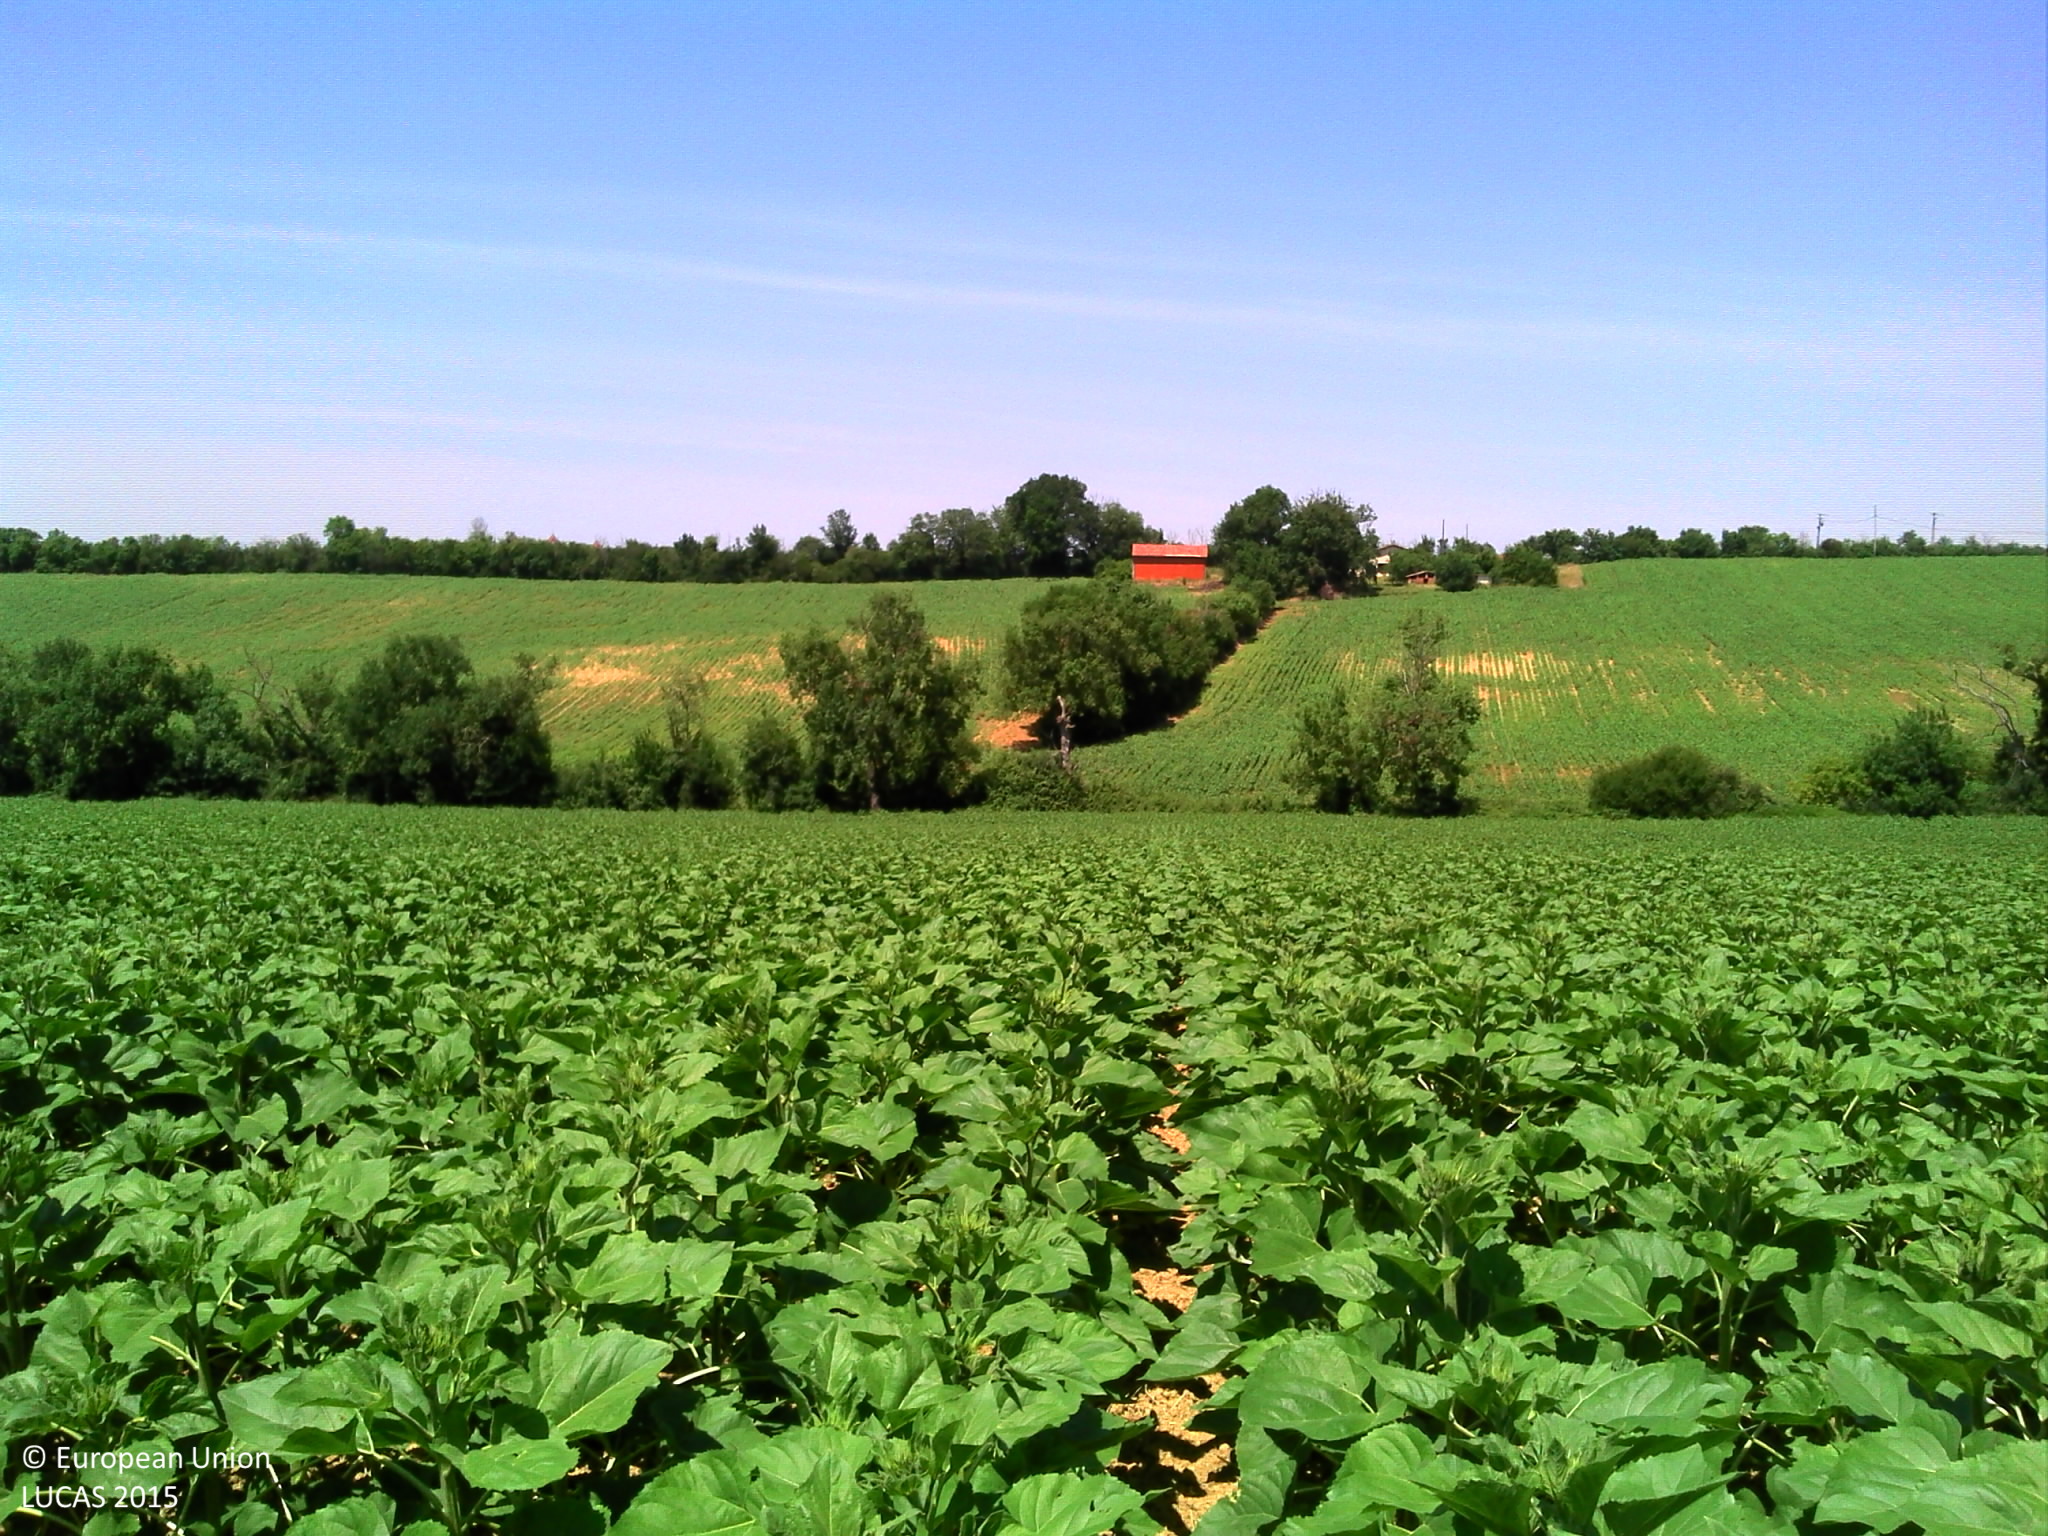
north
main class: Cropland
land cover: Sunflower
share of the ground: > 75 %
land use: Agriculture (excluding fallow land and kitchen gardens)
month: June
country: FR
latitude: 43.7251
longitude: 1.0247
